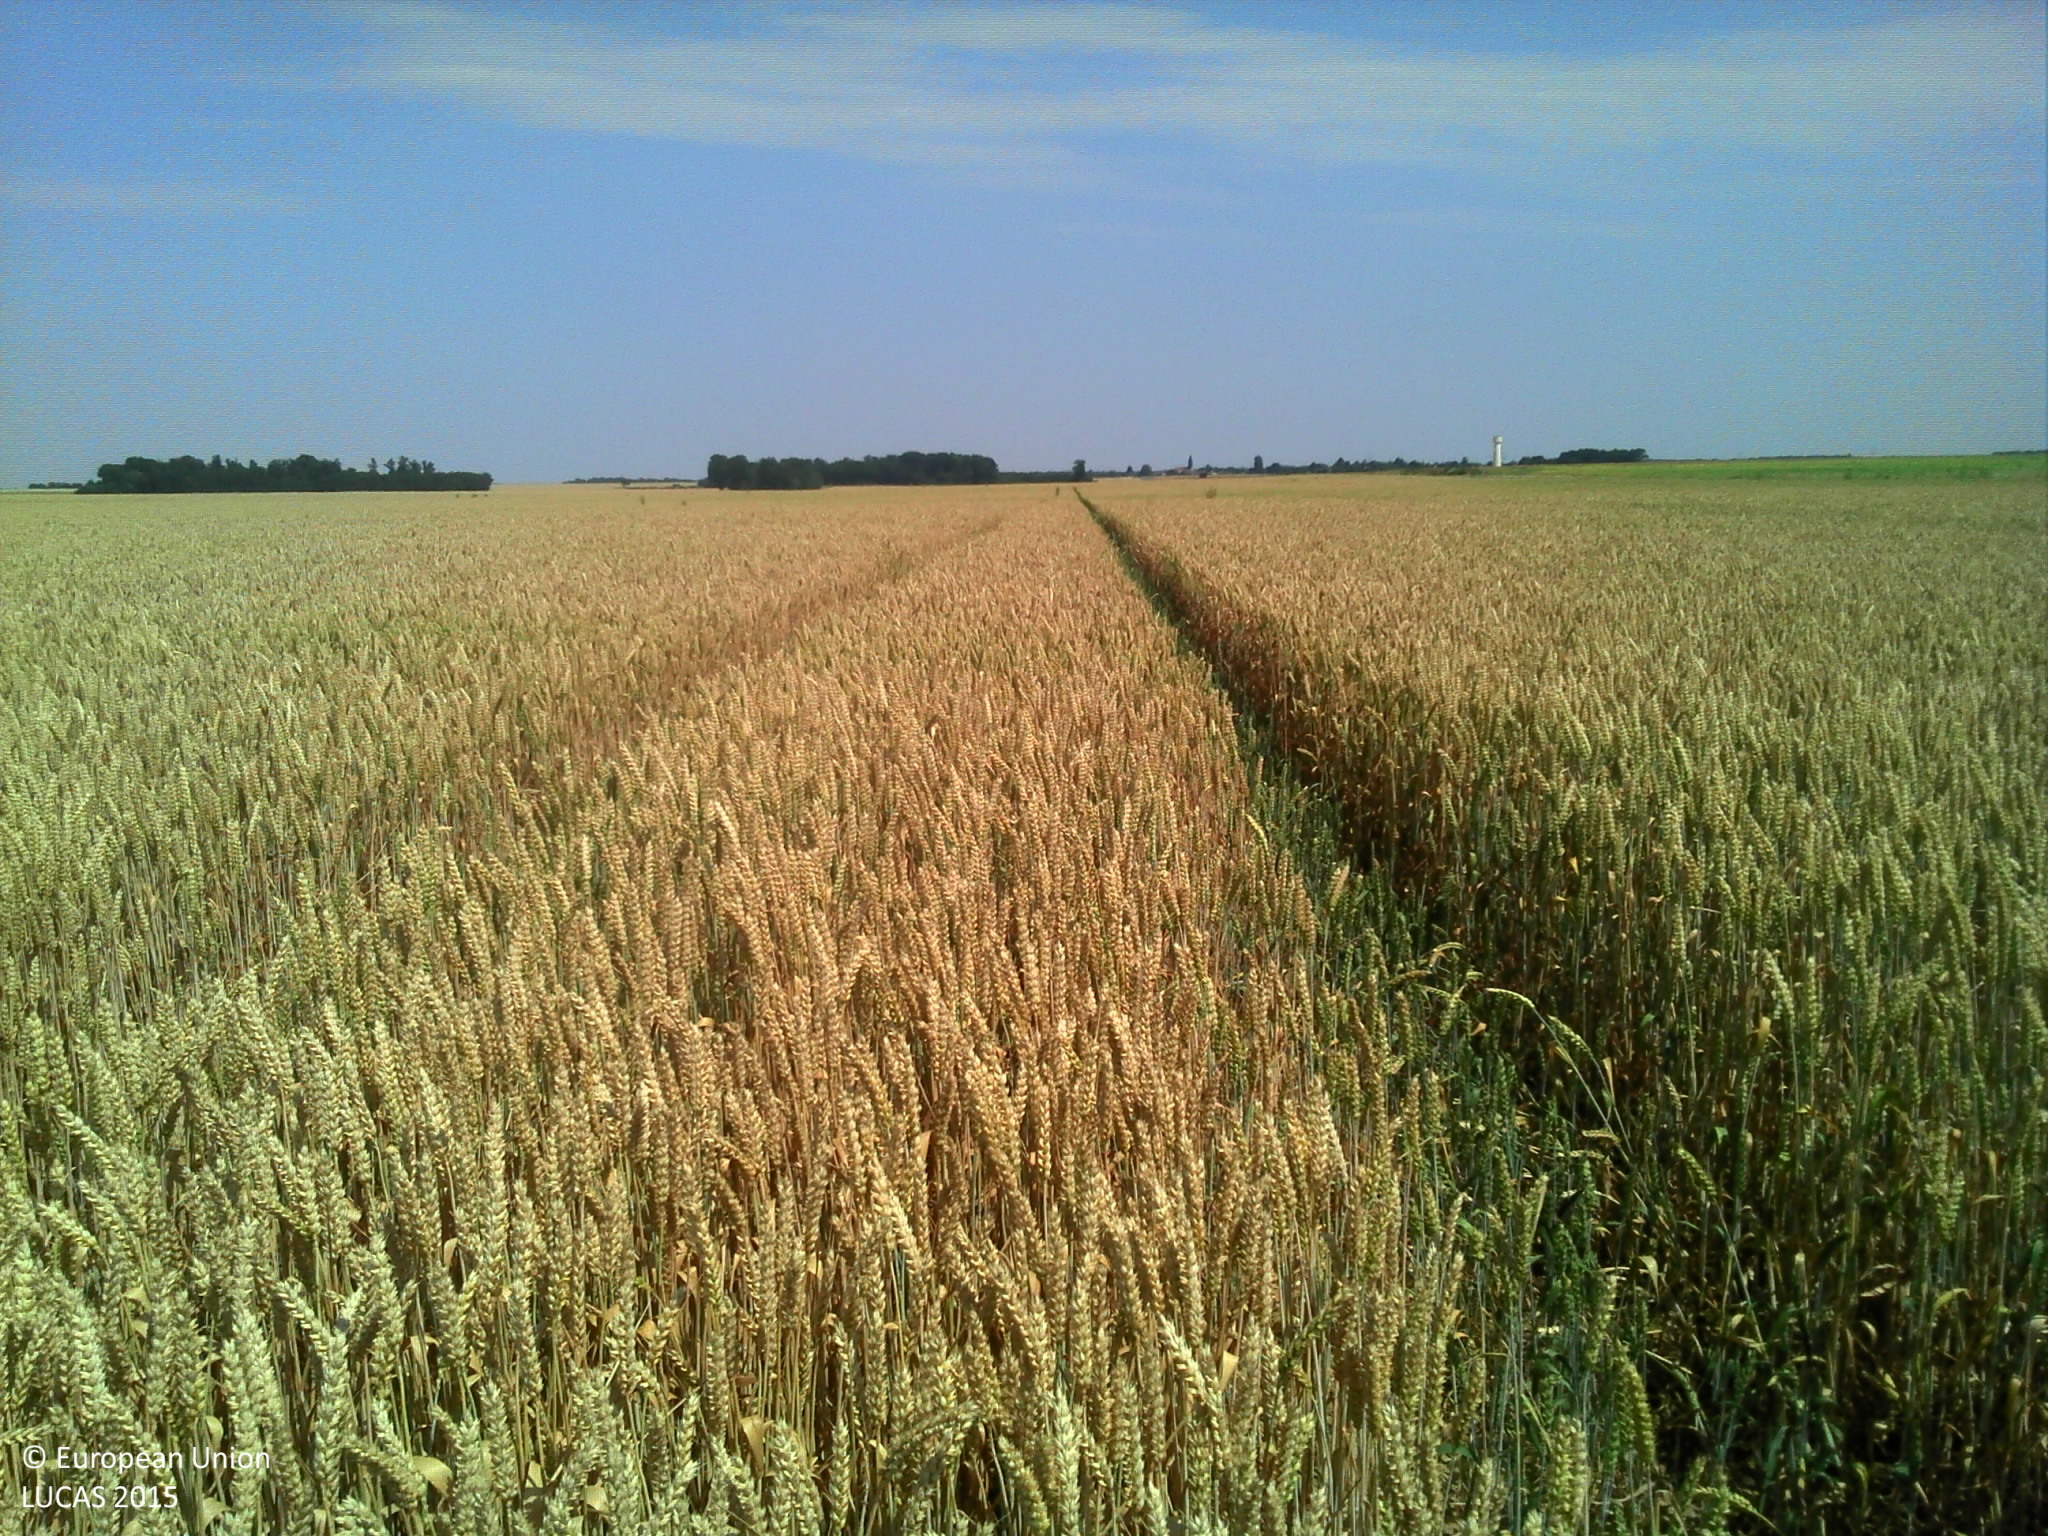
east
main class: Cropland
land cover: Common wheat
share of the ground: > 75 %
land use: Agriculture (excluding fallow land and kitchen gardens)
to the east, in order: Common wheat
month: July
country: FR
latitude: 48.9118
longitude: 1.3166
